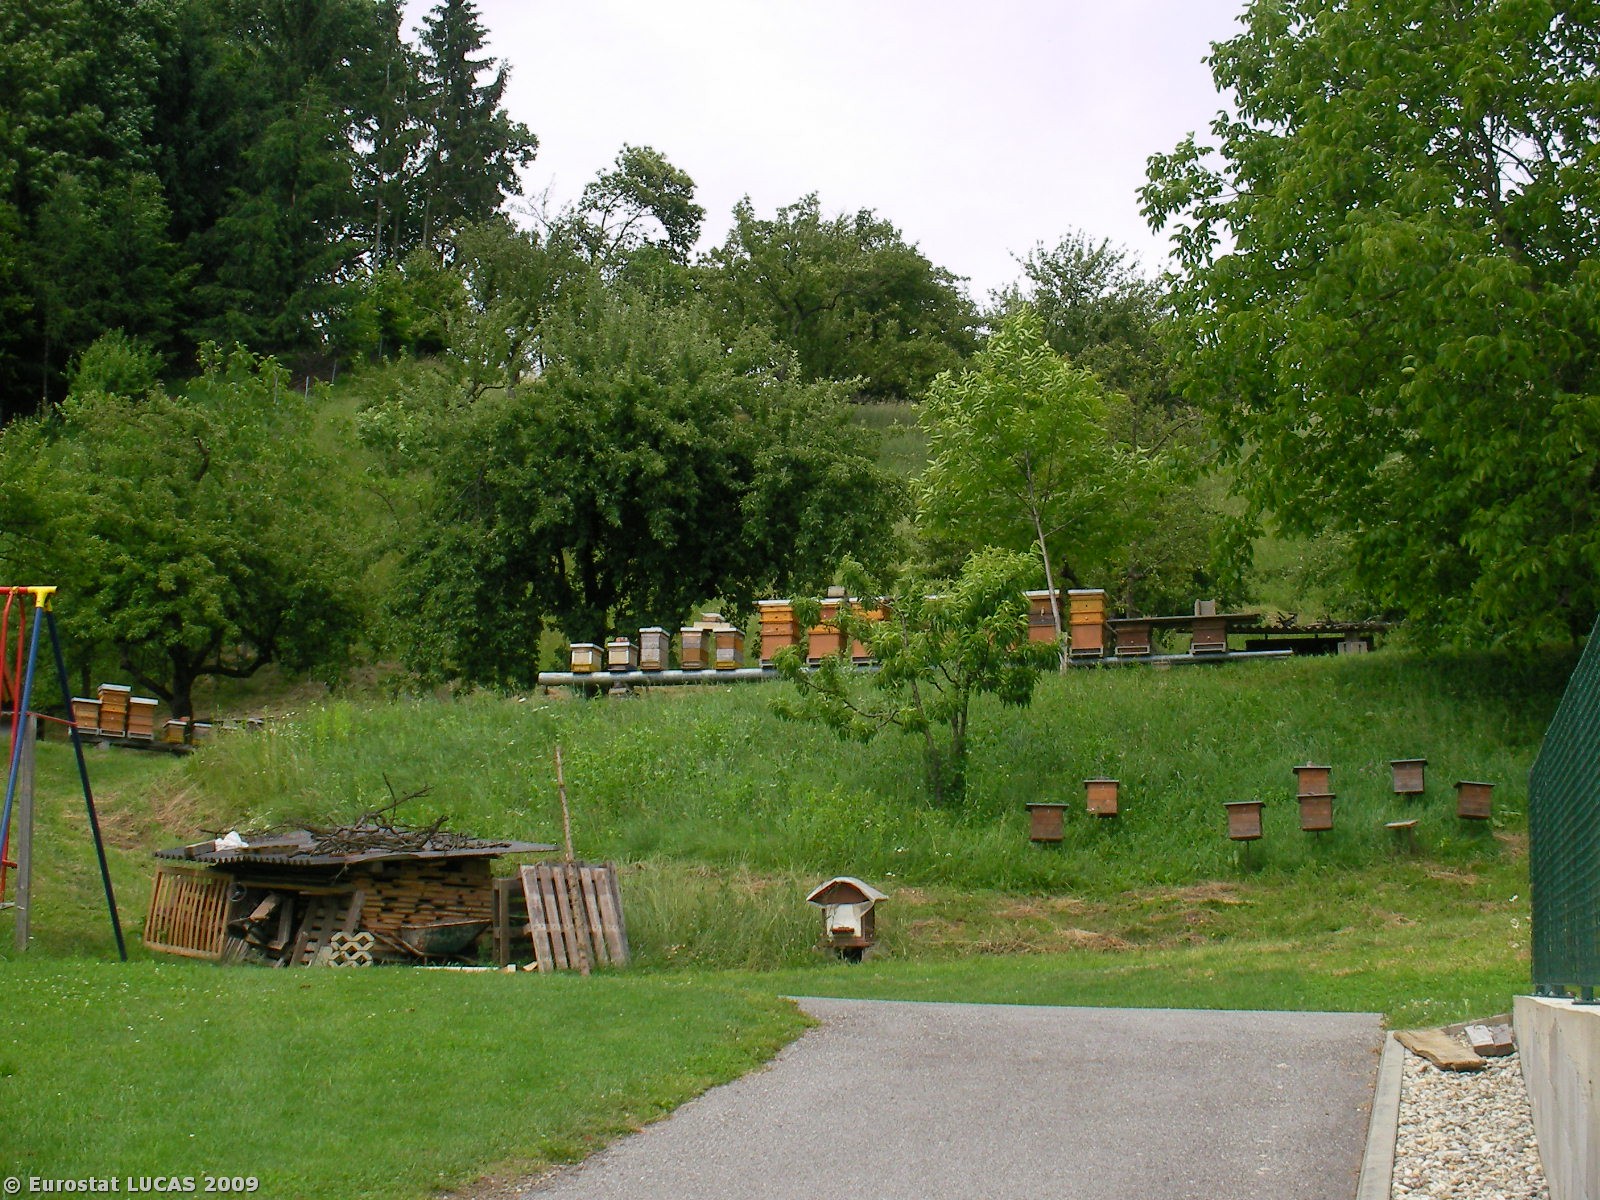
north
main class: Artificial land
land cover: Buildings with 1 to 3 floors
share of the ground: > 75 %
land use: Residential
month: June
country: AT
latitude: 46.8929
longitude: 15.5516
